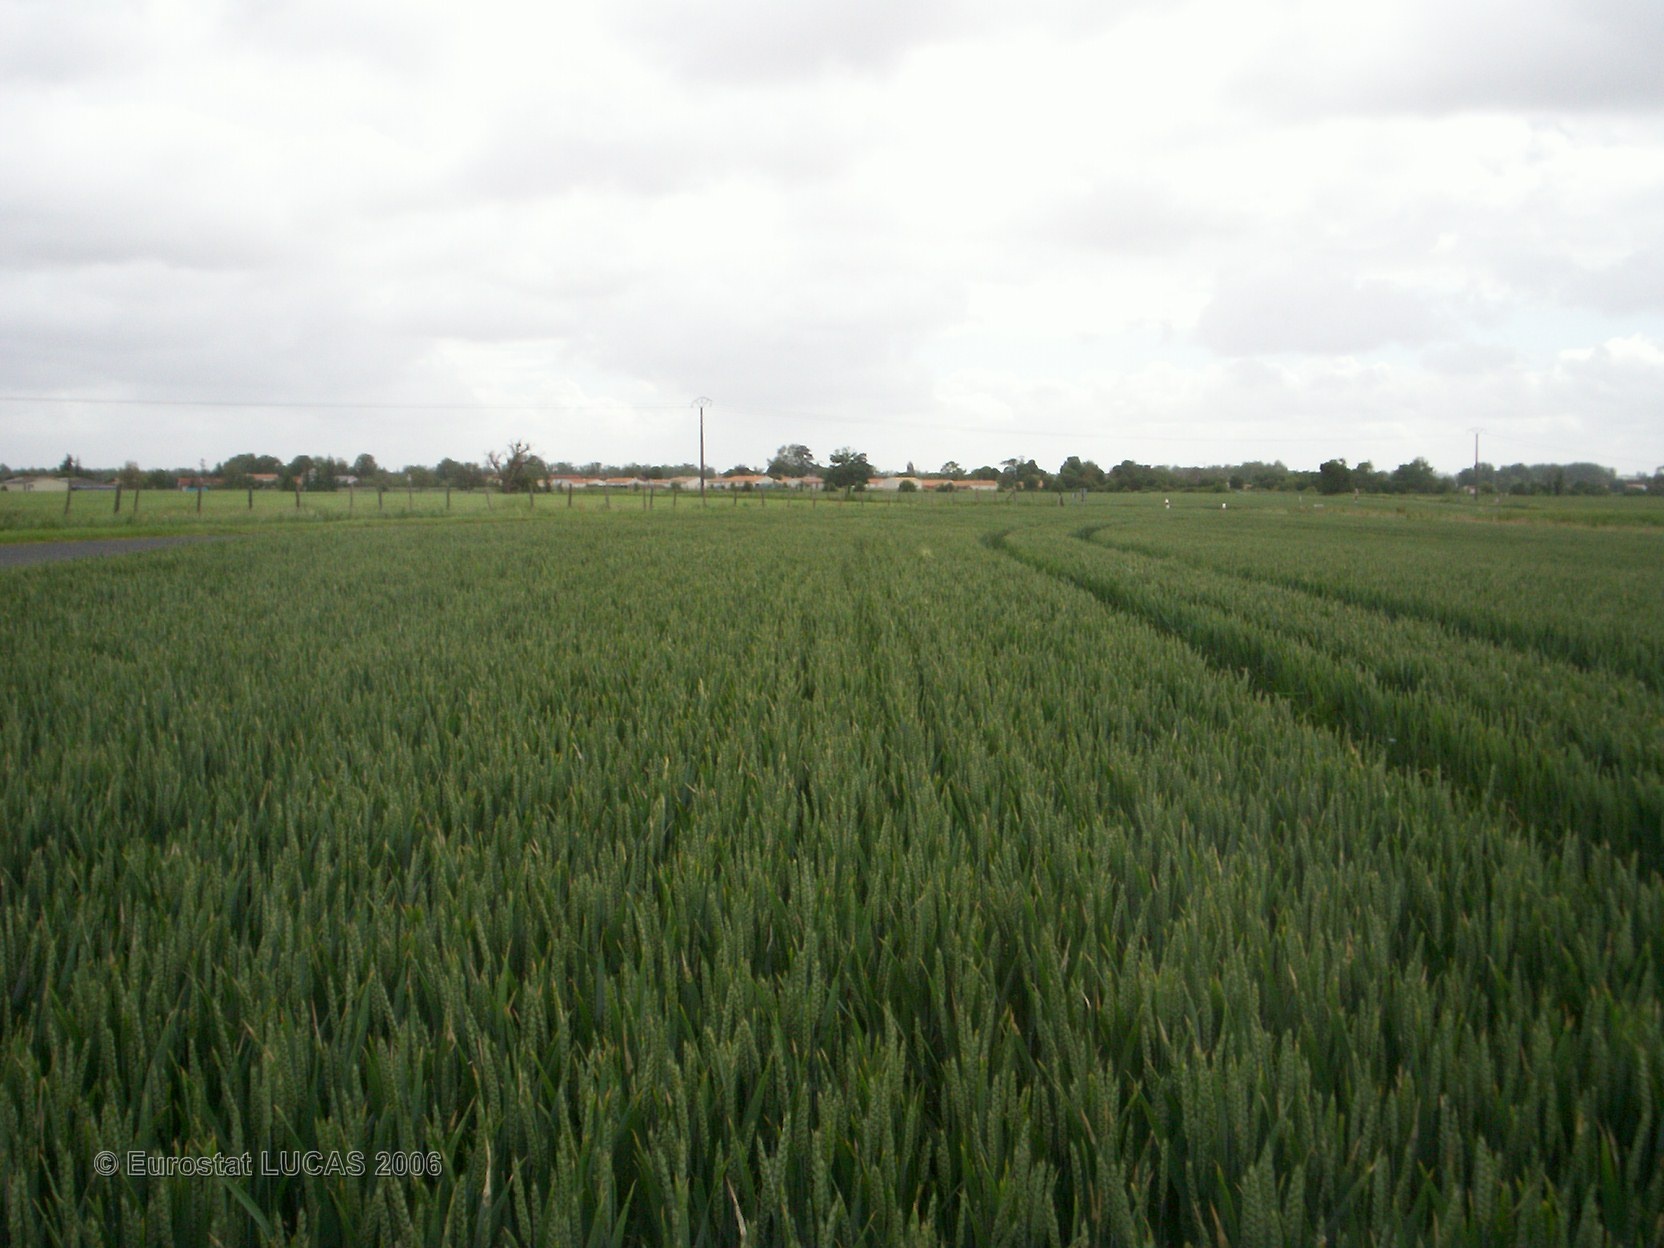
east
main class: Cropland
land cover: Common wheat
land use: Agriculture (excluding fallow land and kitchen gardens)
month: May
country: FR
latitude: 45.8210
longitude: -0.7993
